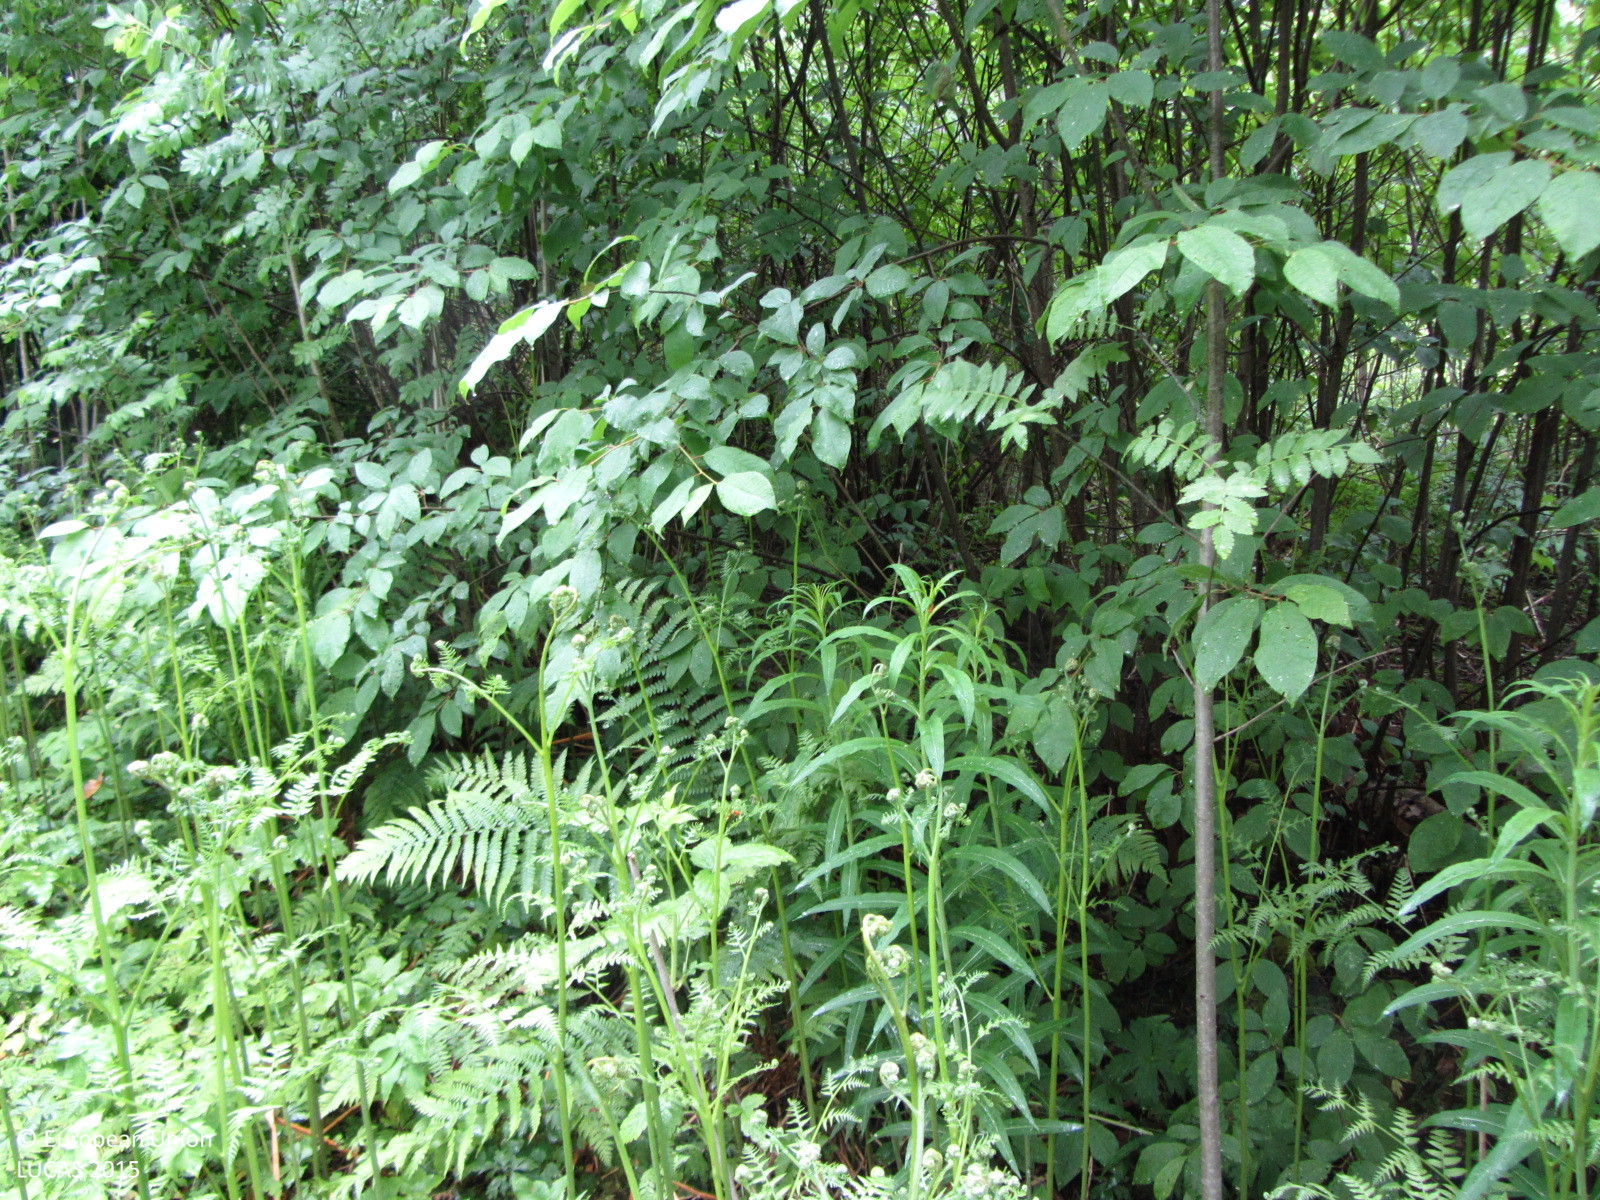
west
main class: Woodland
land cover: Other mixed woodland
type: boreal forest
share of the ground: 50 - 75 %
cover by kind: broadleaved forest trees 40 %, herbaceous plants 35 %, coniferous forest trees 25 %
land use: Forestry
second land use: Residential
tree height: > 5 m
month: June
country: FI
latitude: 60.4327
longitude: 24.7000
